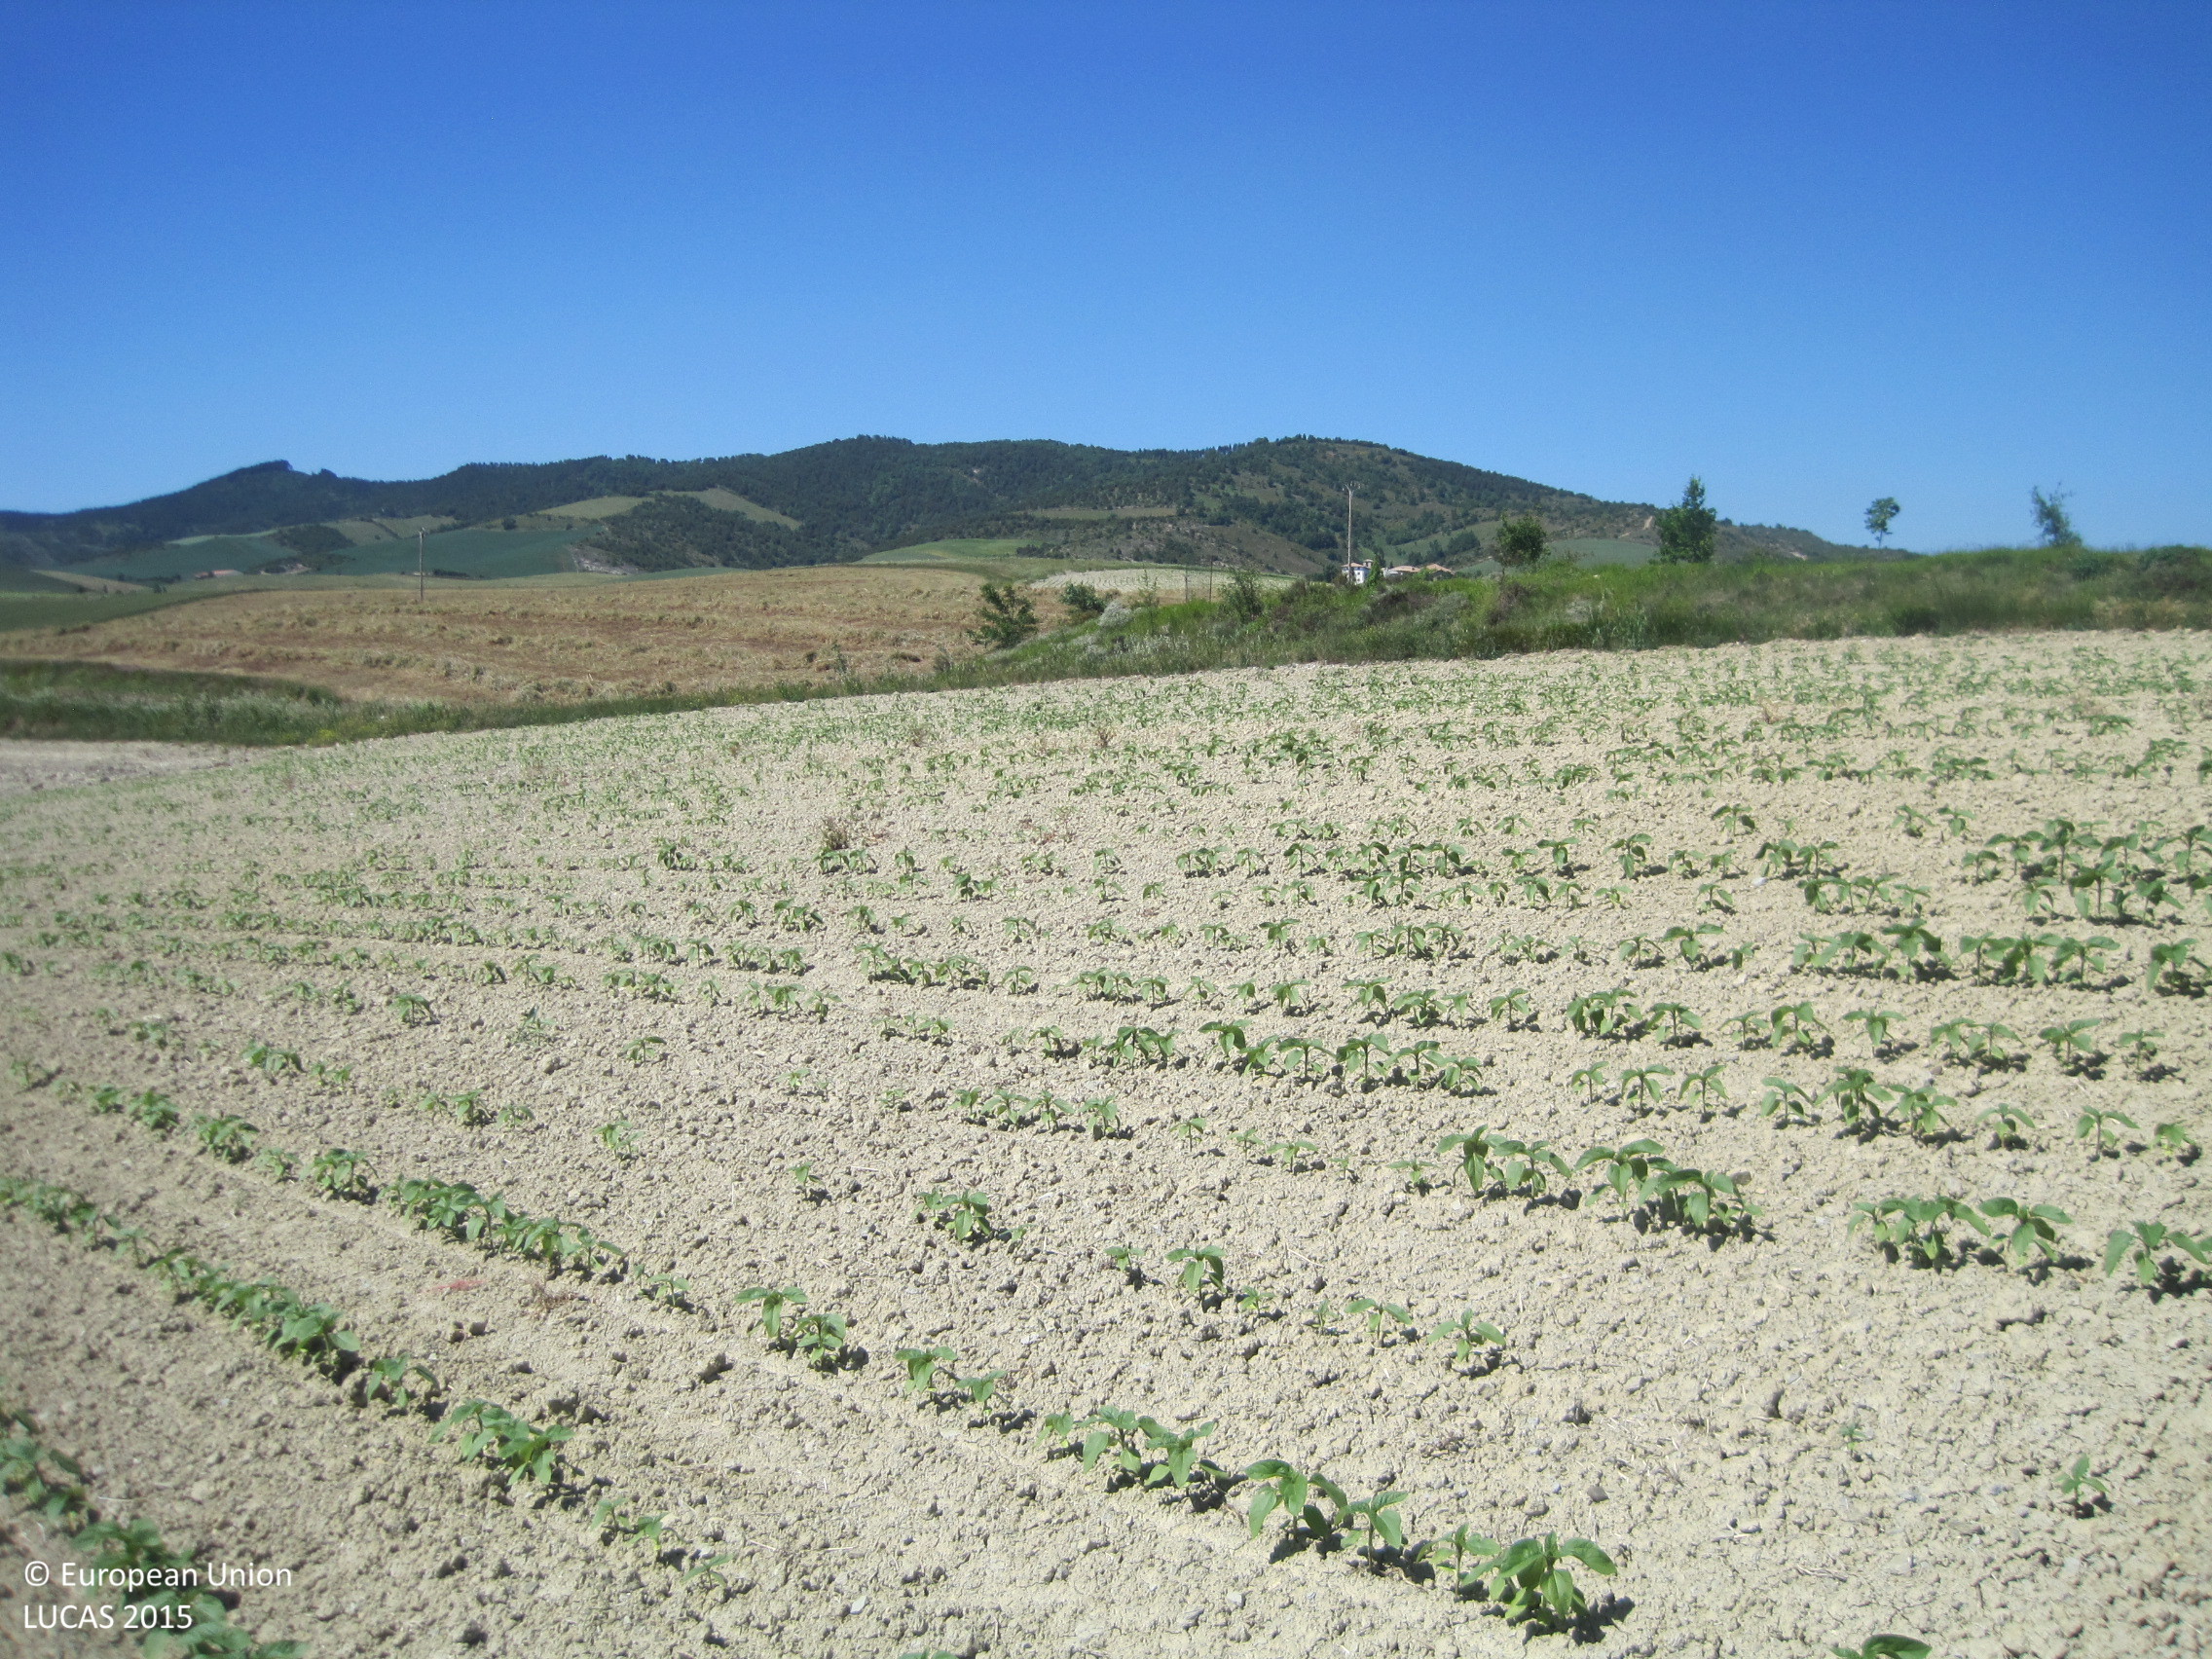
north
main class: Cropland
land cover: Sunflower
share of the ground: < 10 %
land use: Agriculture (excluding fallow land and kitchen gardens)
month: May
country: ES
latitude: 42.8019
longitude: -1.4699
